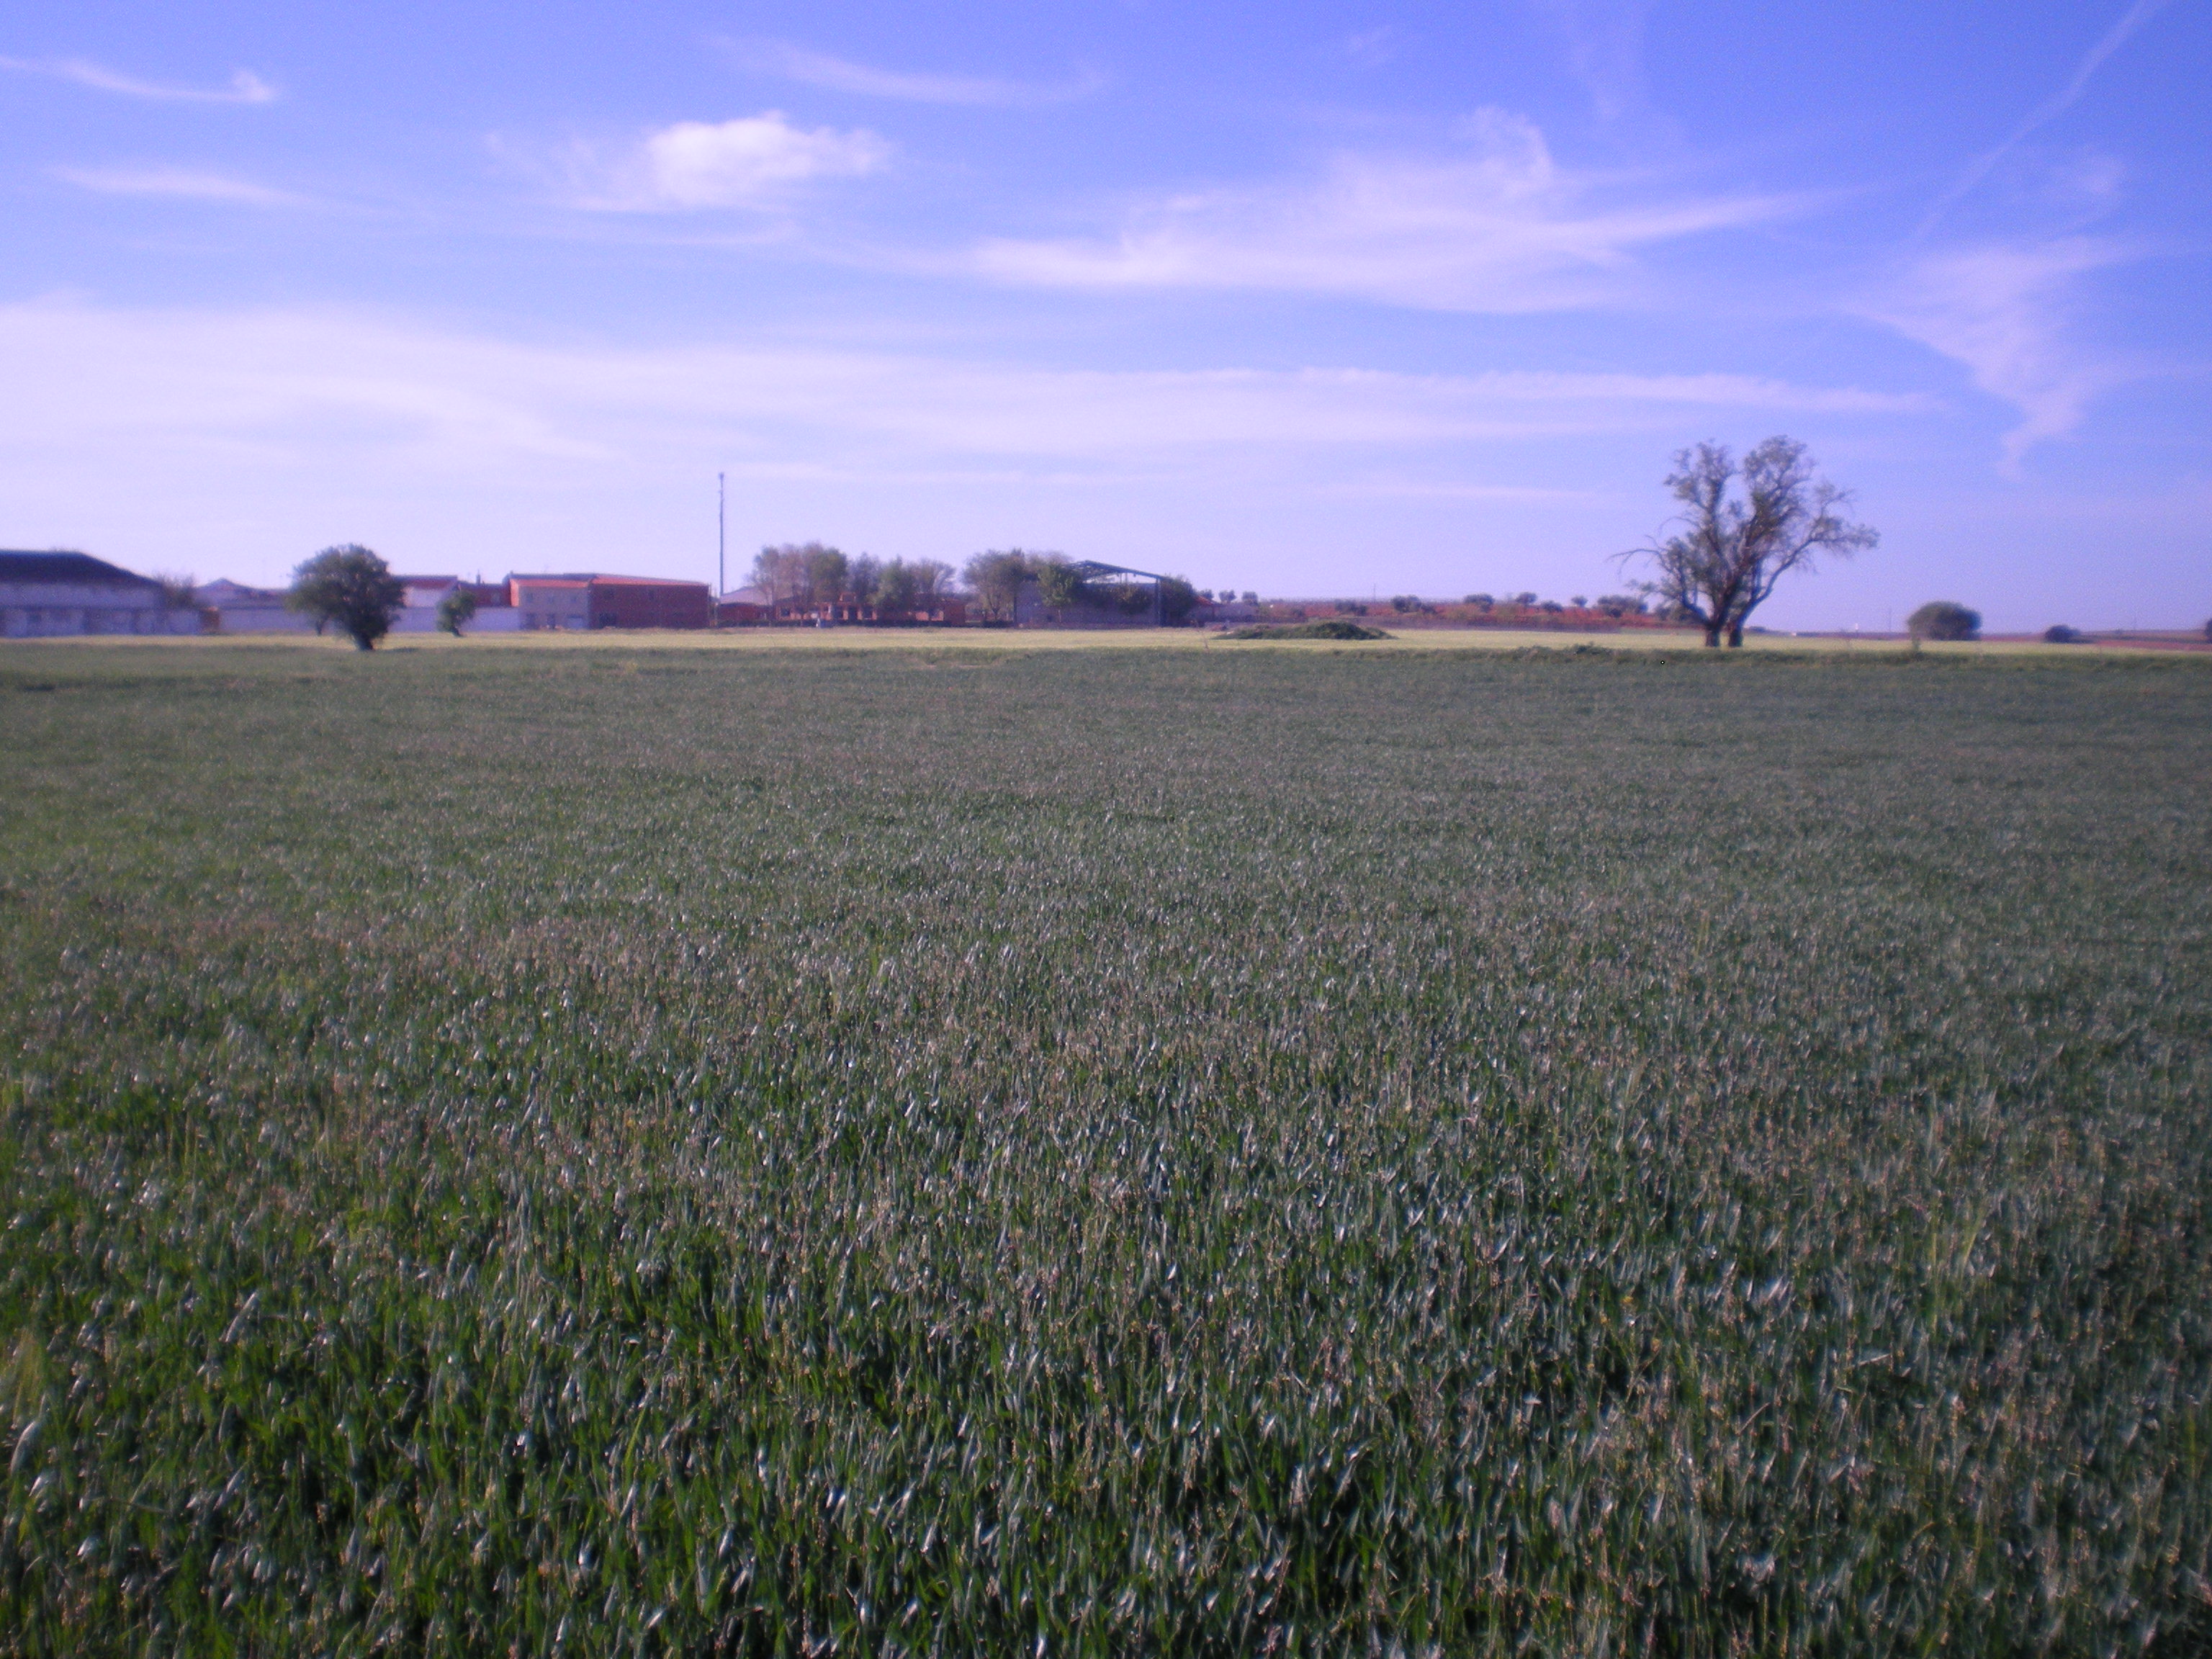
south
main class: Cropland
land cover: Durum wheat
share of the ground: > 75 %
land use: Agriculture (excluding fallow land and kitchen gardens)
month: April
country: ES
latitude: 38.7801
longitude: -3.2360
